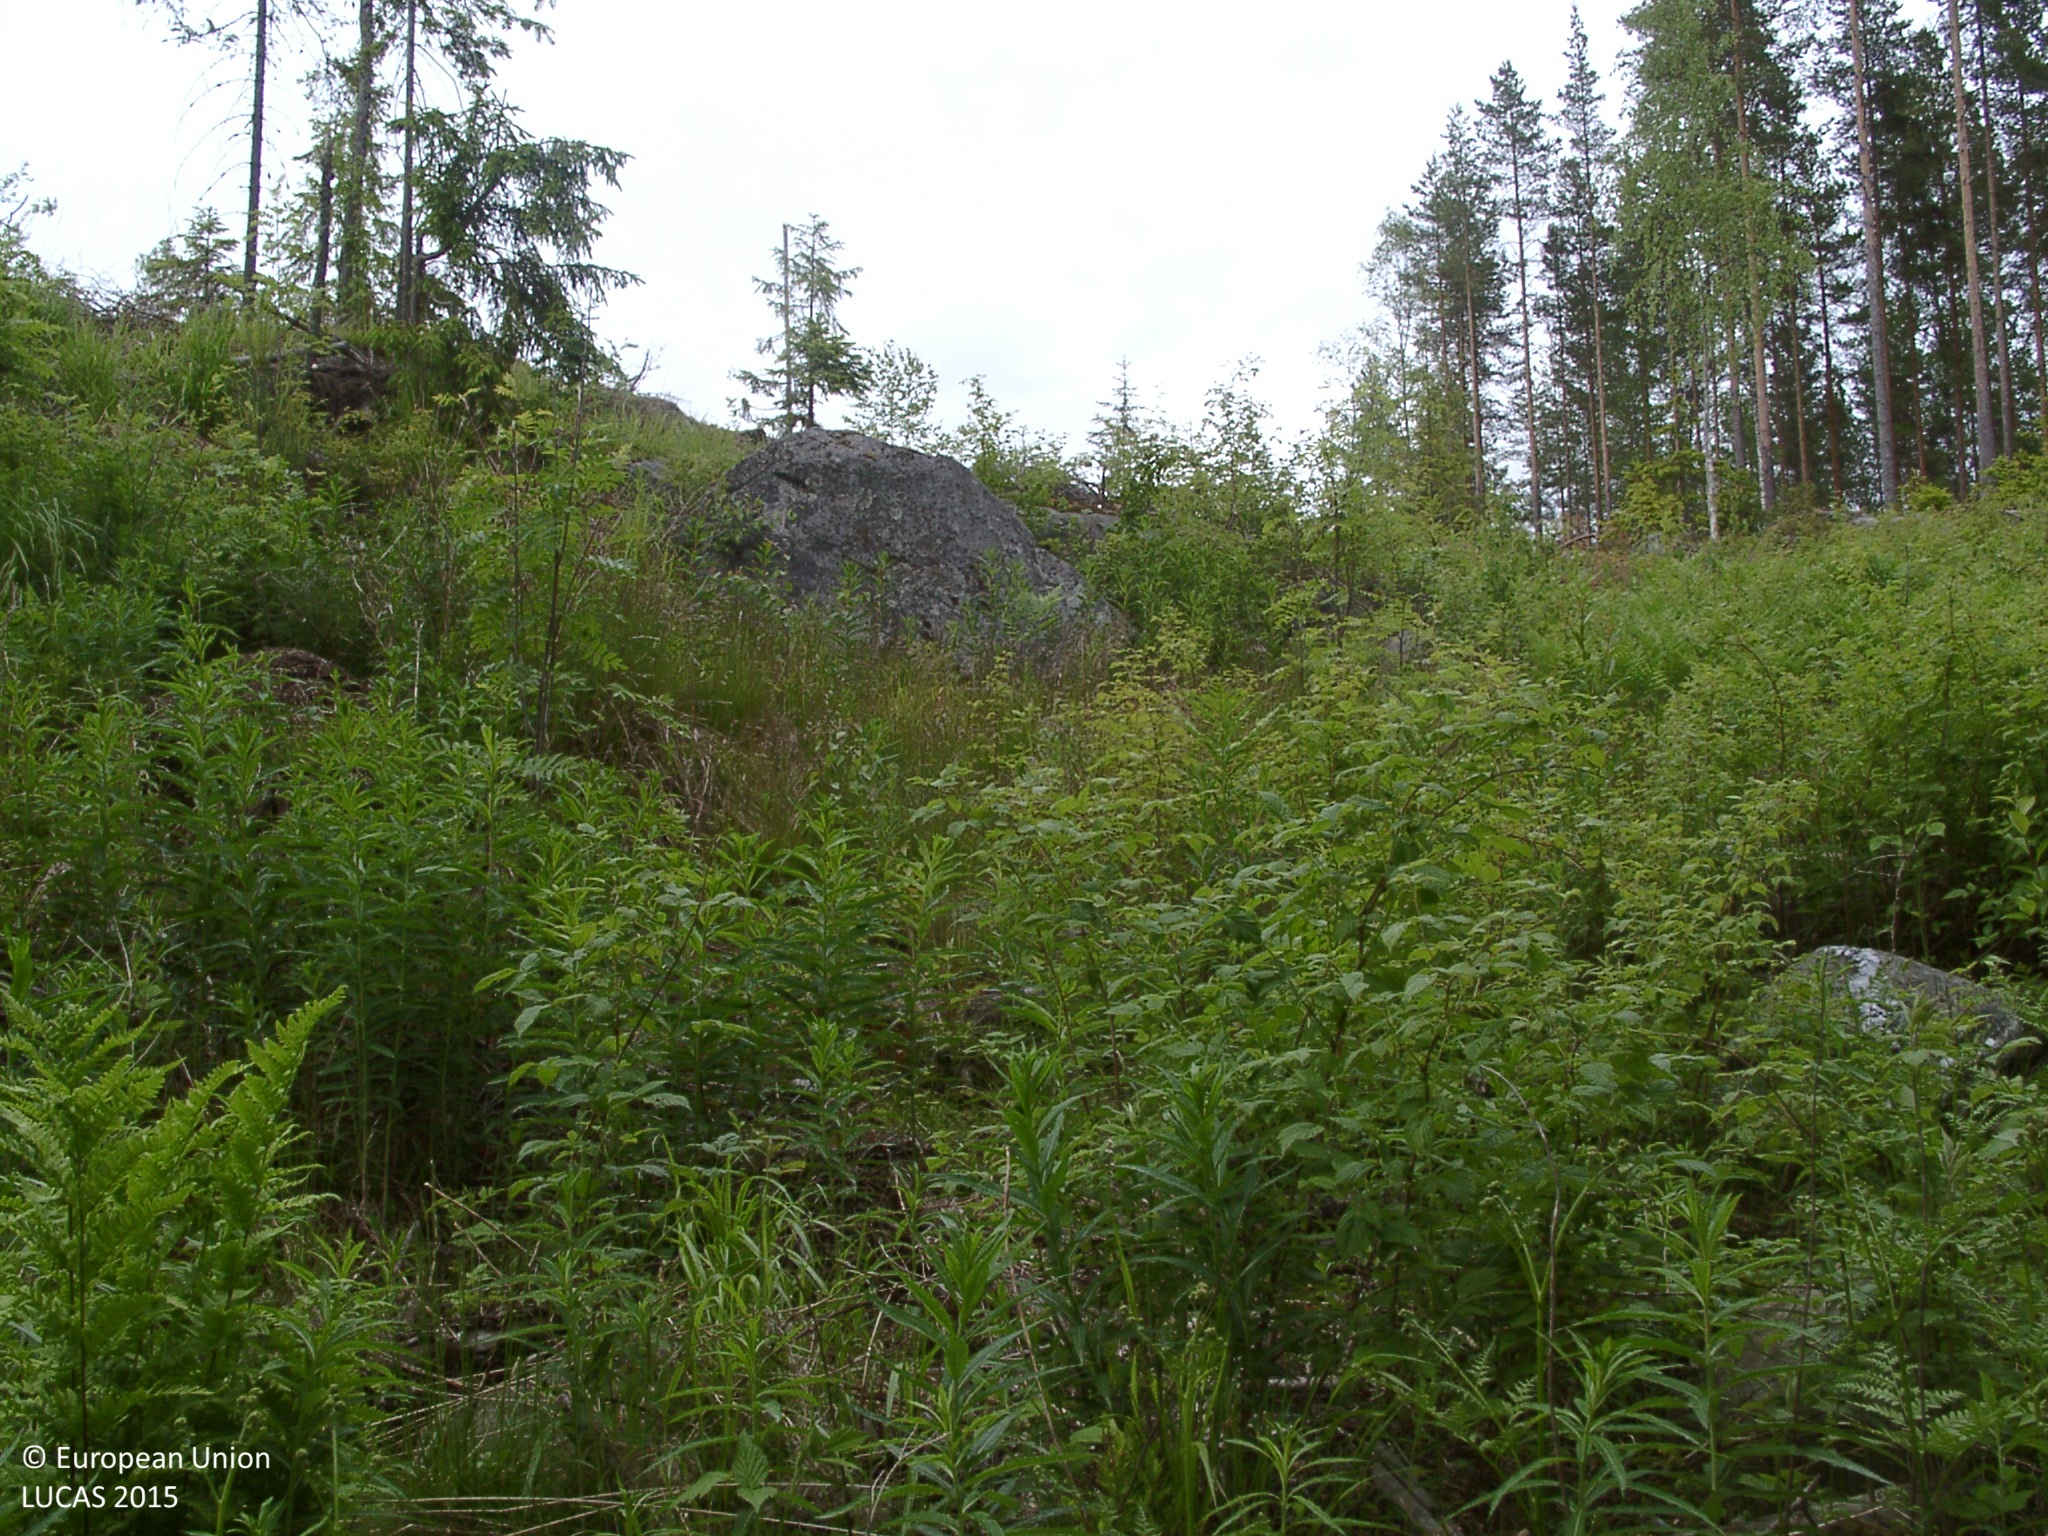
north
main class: Shrubland
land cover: Shrubland with sparse tree cover
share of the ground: 25 - 50 %
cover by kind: herbaceous plants 50 %, shrubs 40 %, broadleaved forest trees 5 %, consolidated bare surface 5 %
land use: Forestry
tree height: < 5 m
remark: Clear cut
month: June
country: FI
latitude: 61.6080
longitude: 24.7125
